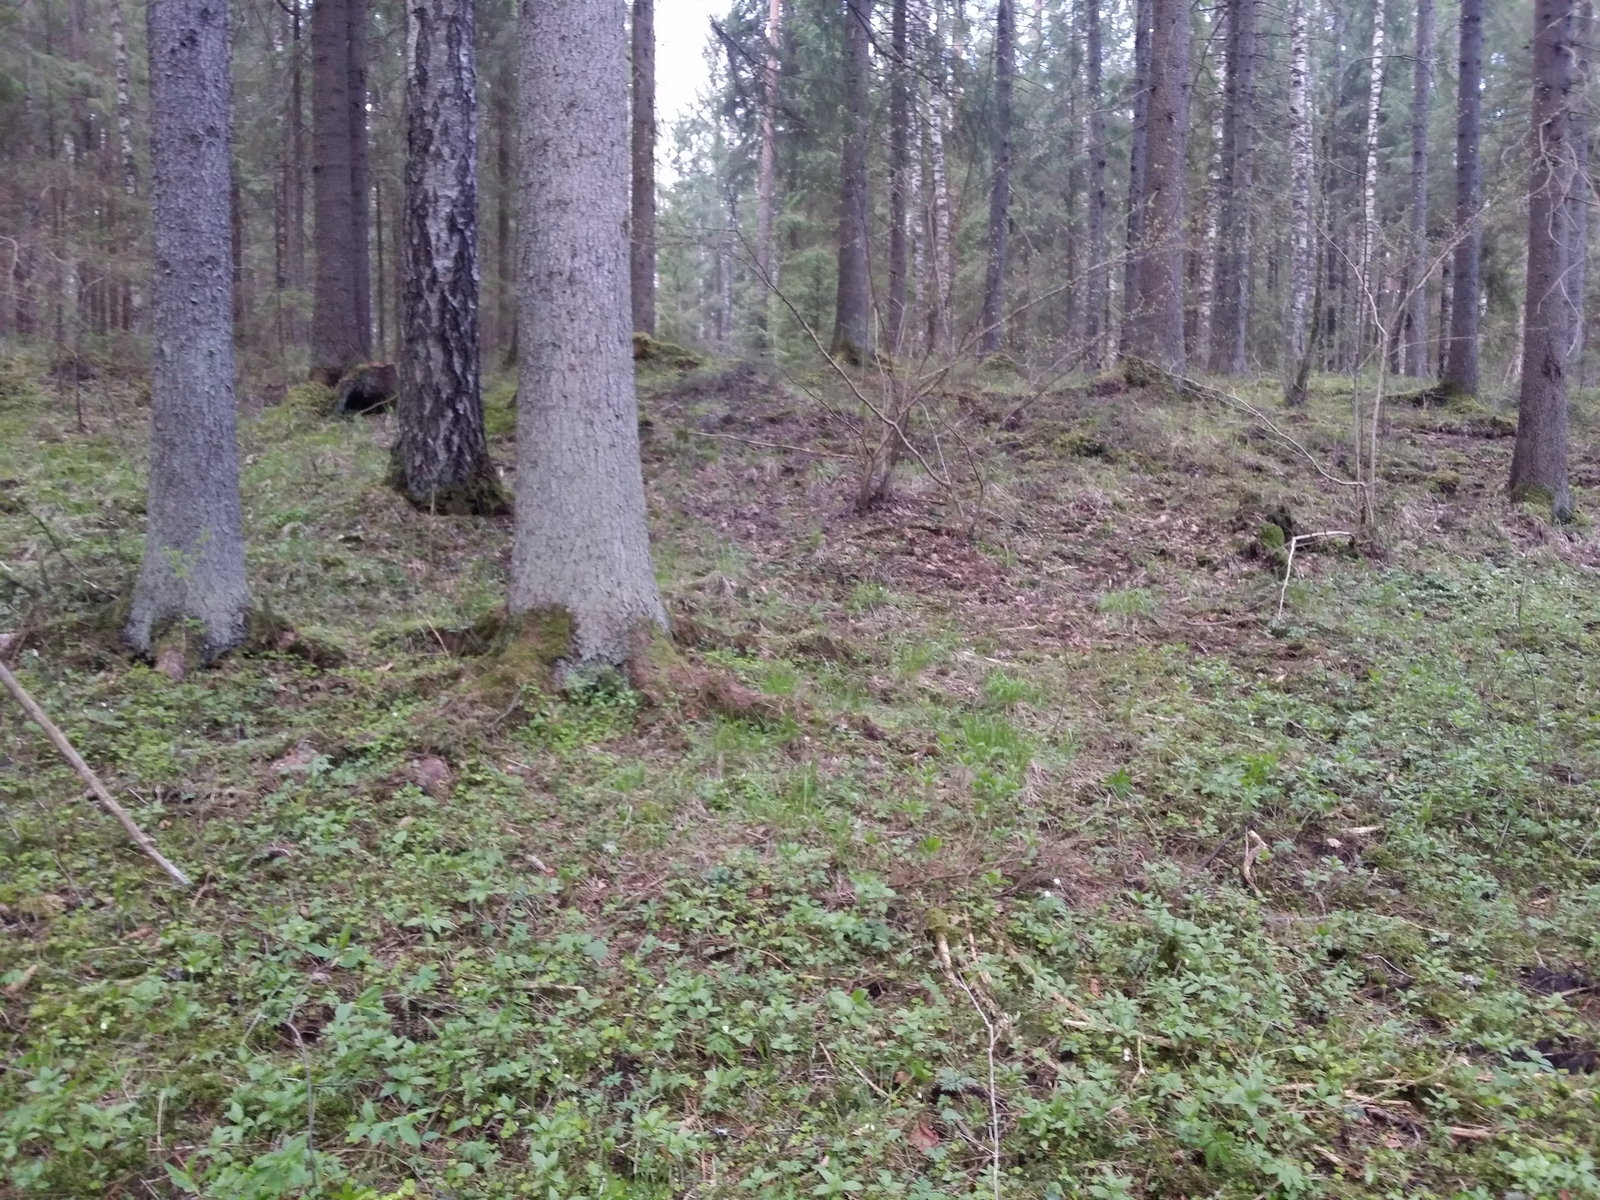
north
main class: Woodland
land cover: Spruce dominated mixed woodland
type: hemiboreal forest and nemoral coniferous forest and mixed broadleaved-coniferous forest
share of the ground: > 75 %
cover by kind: coniferous forest trees 65 %, broadleaved forest trees 25 %, lichens and mosses 10 %
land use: Forestry
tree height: > 5 m
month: May
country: LV
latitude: 57.3785
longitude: 26.0129
